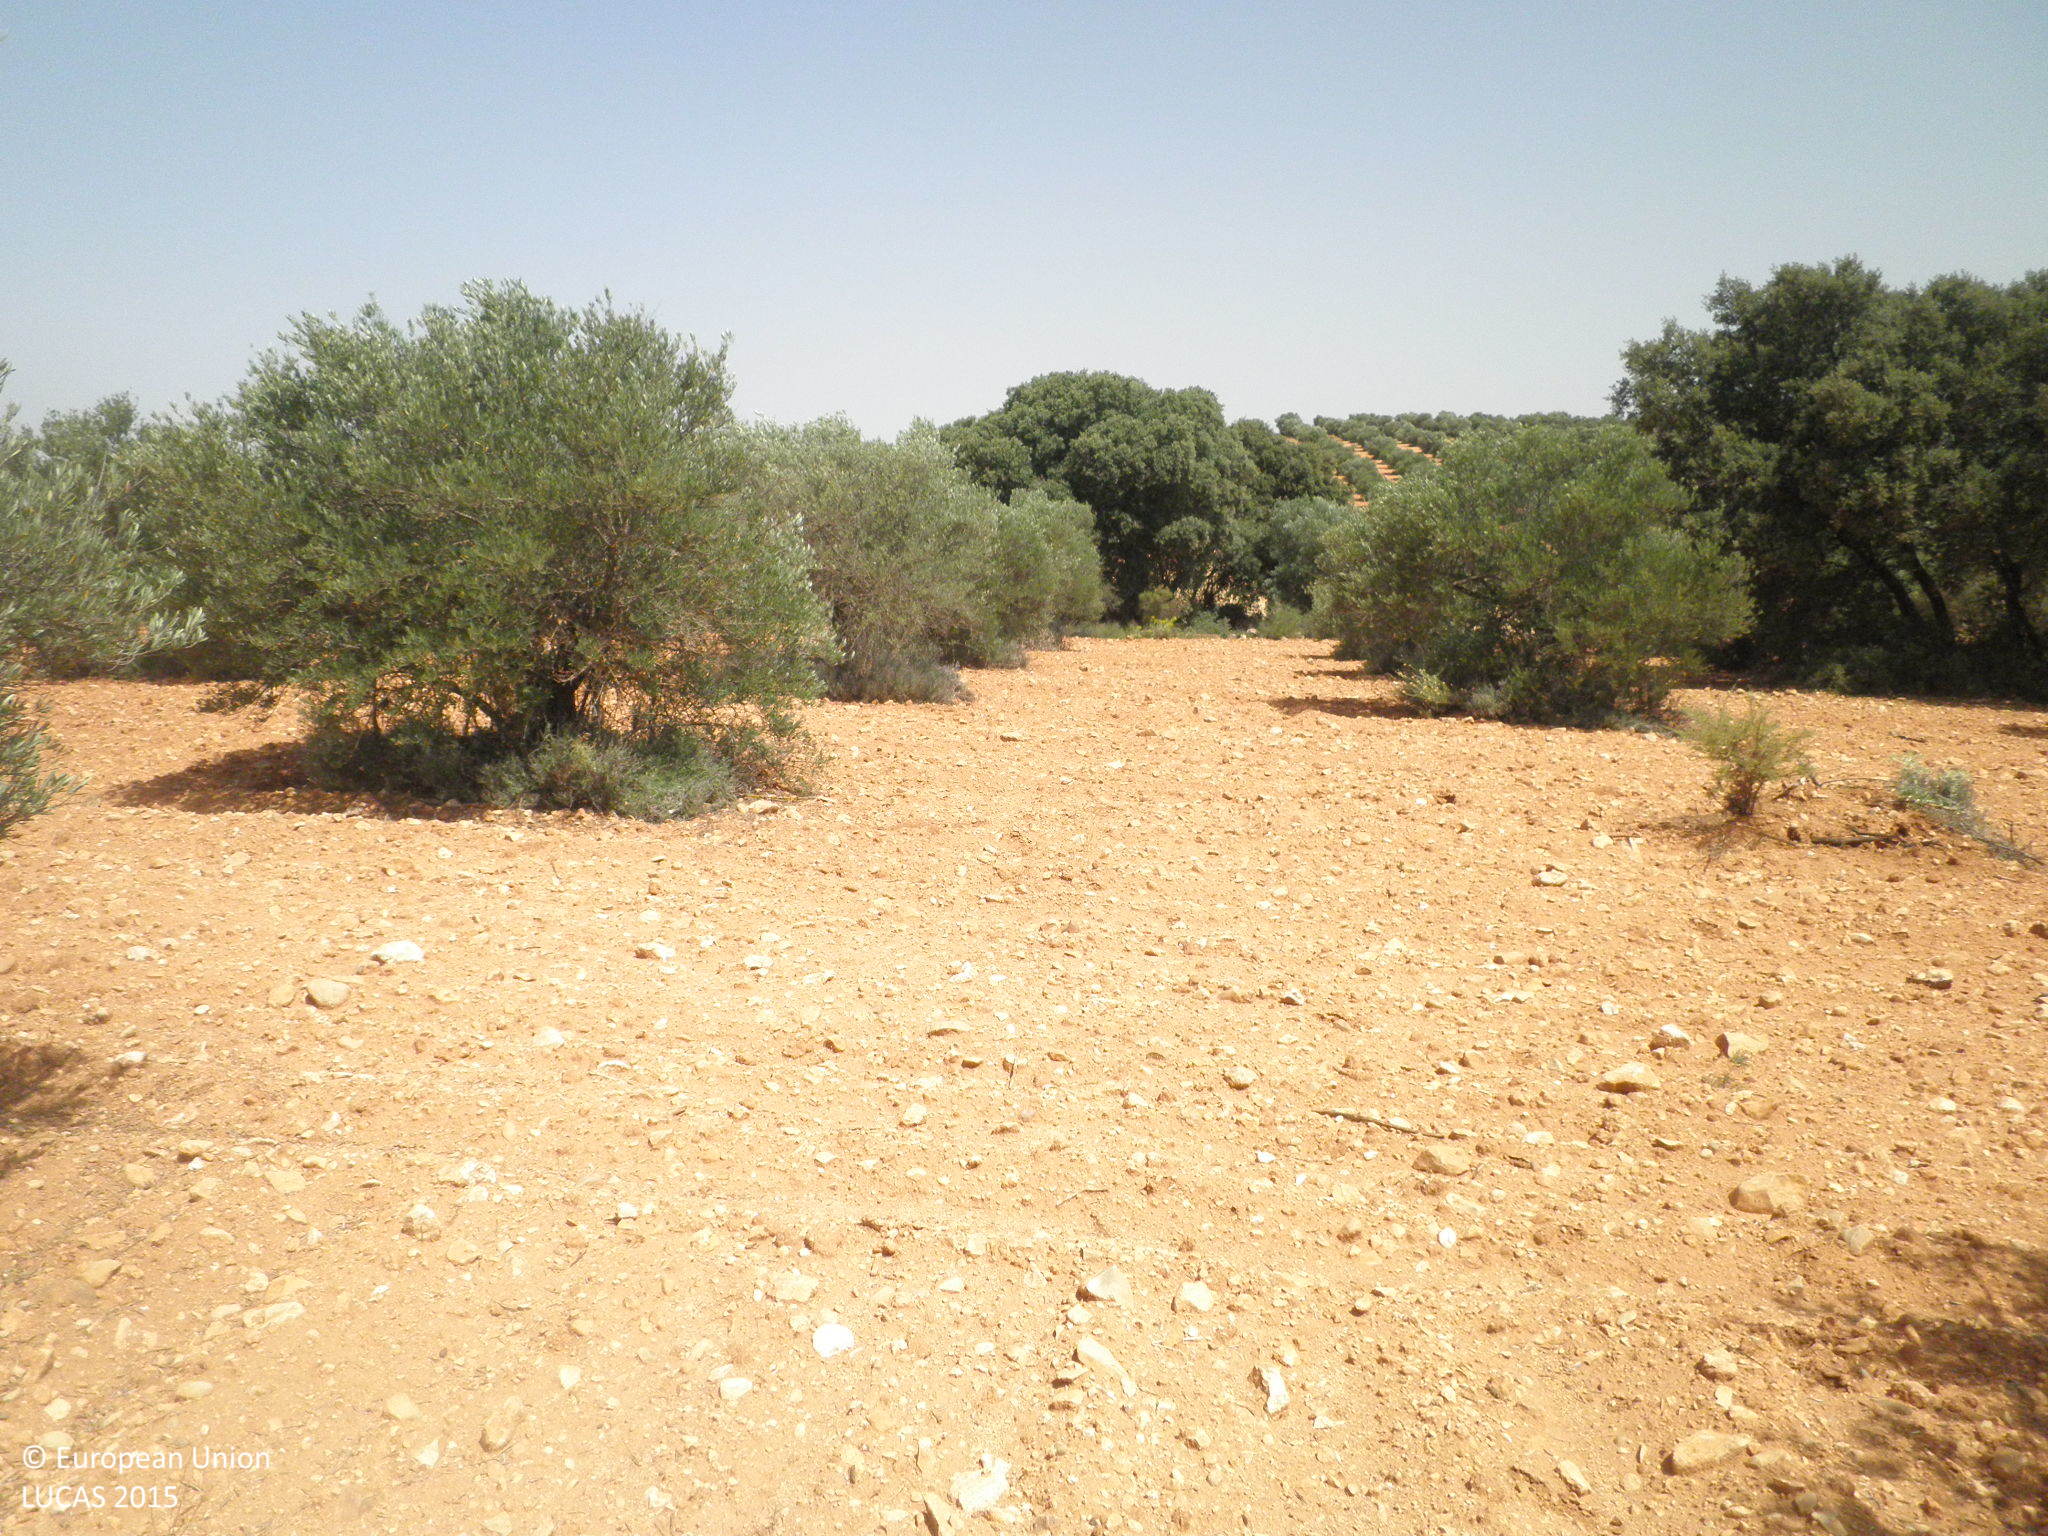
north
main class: Cropland
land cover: Olive groves
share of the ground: 10 - 25 %
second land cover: Other bare soil
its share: > 75 %
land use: Agriculture (excluding fallow land and kitchen gardens)
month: July
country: ES
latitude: 39.5945
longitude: -2.6257
